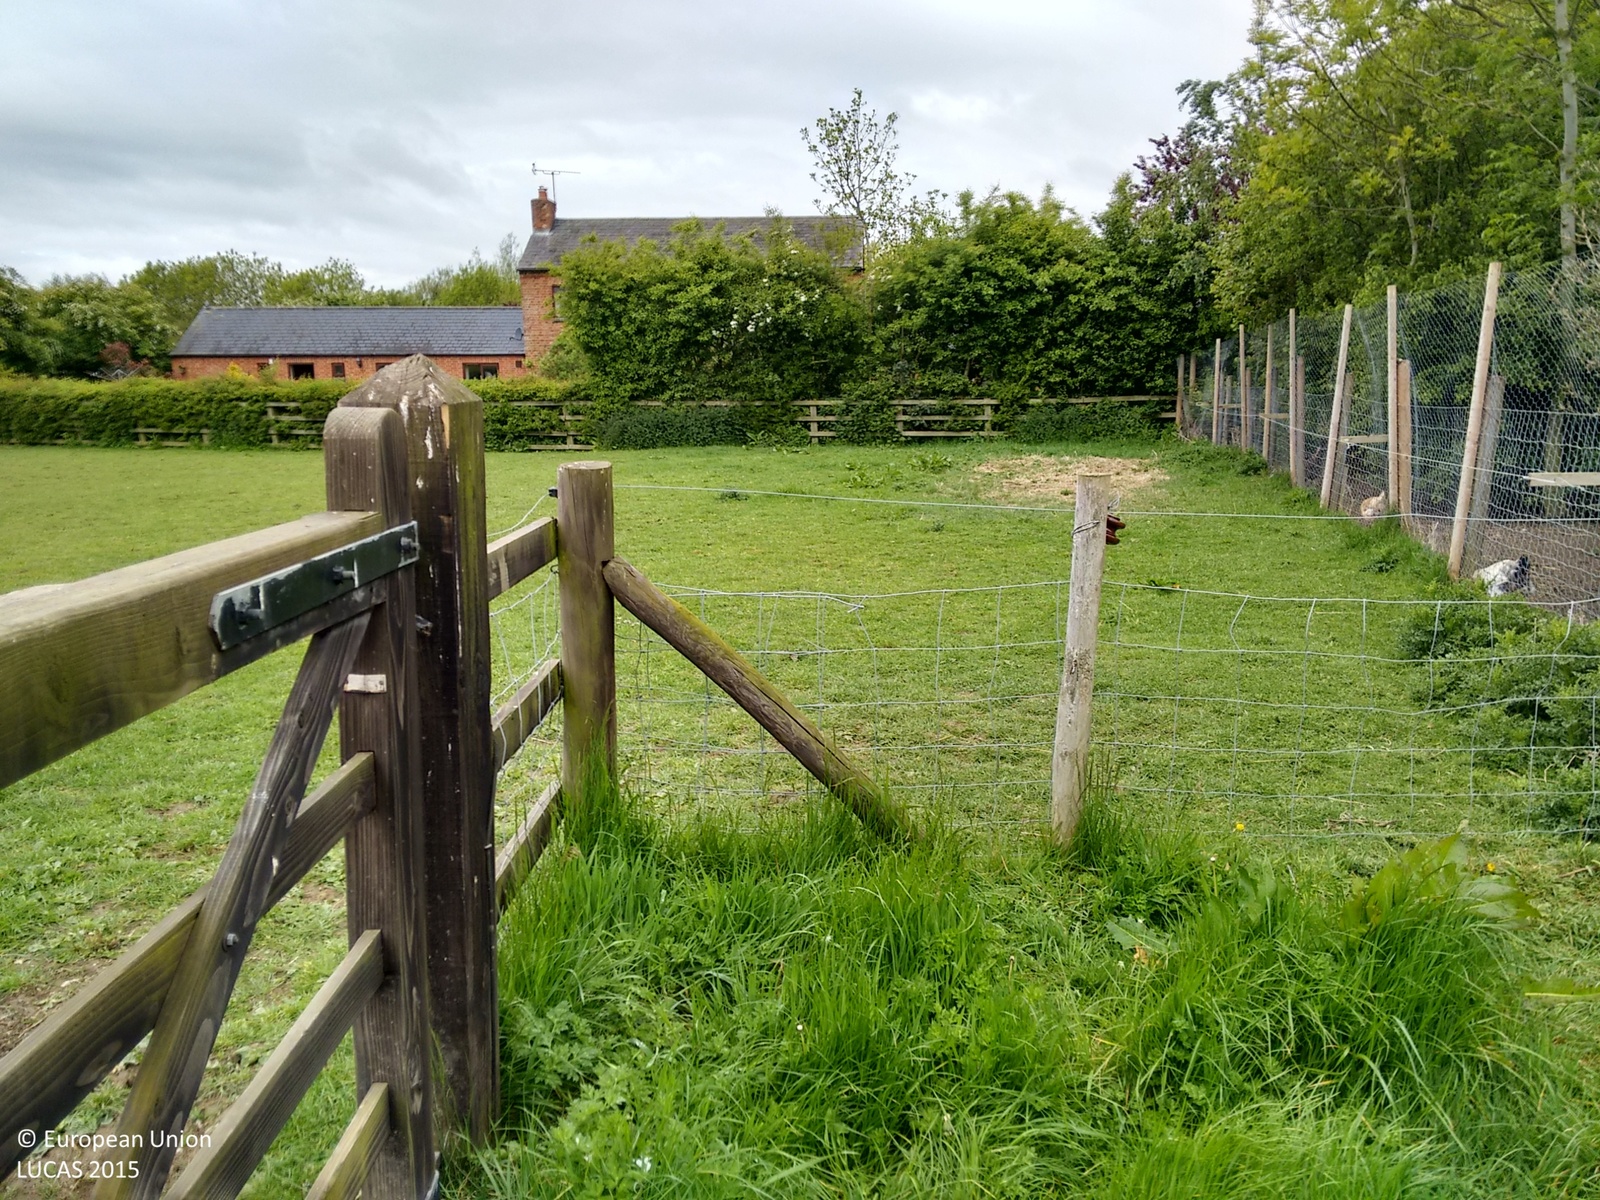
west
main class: Grassland
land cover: Grassland without tree/shrub cover
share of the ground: > 75 %
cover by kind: herbaceous plants 100 %
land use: Agriculture (excluding fallow land and kitchen gardens)
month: May
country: GB
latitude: 52.2607
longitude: -1.2262
